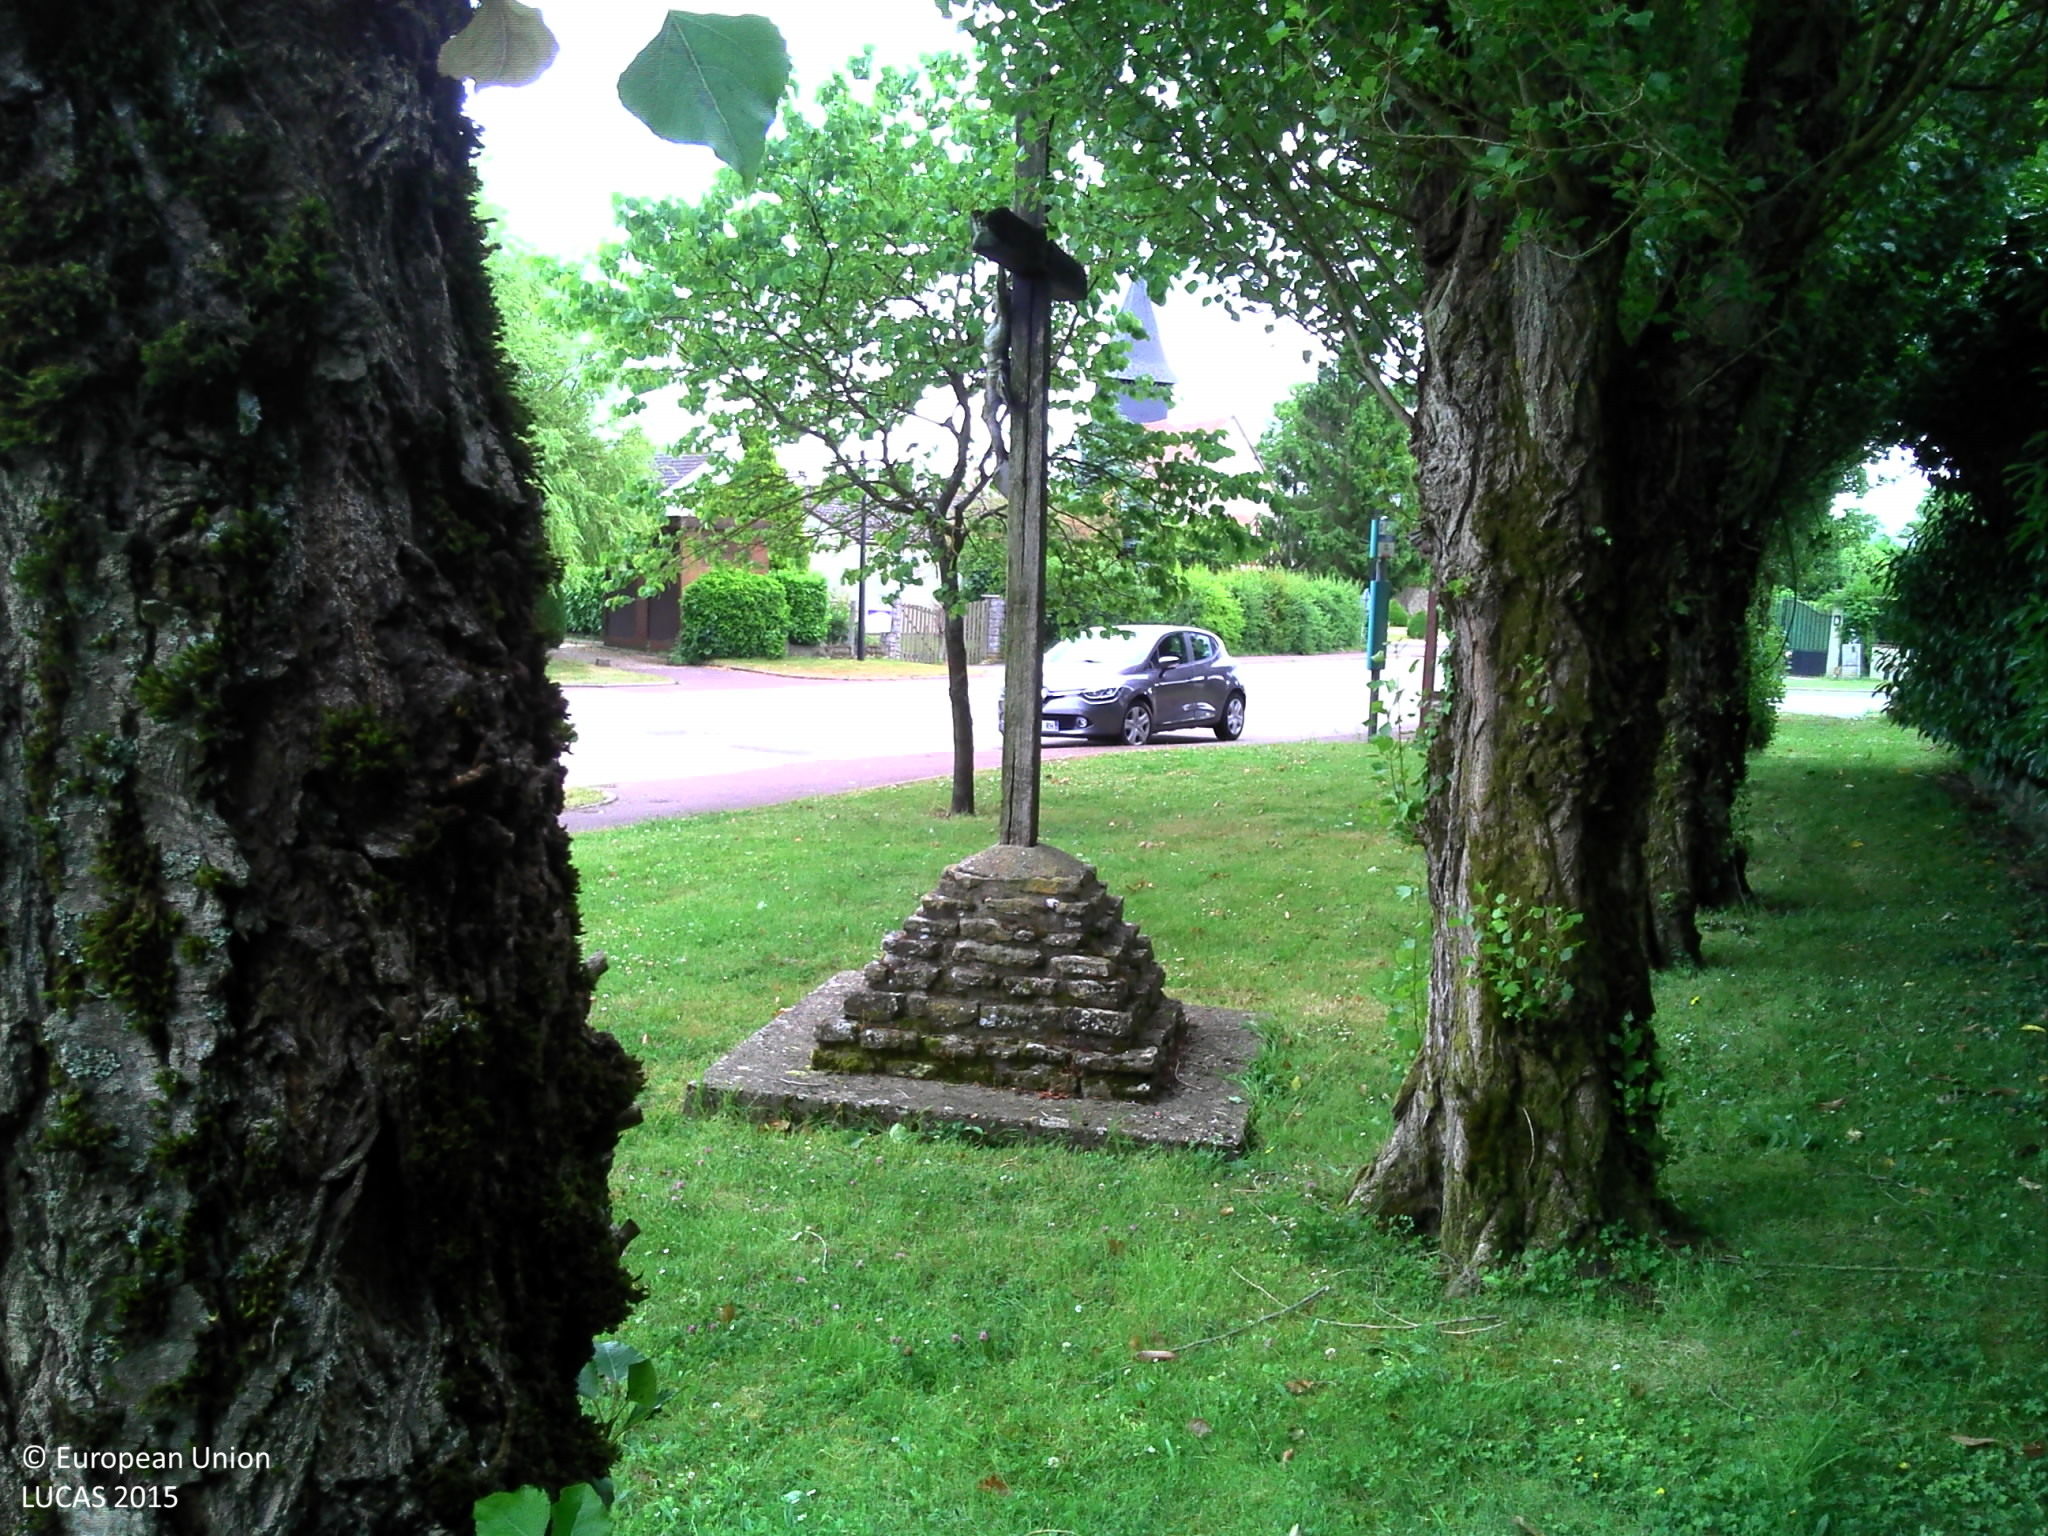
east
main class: Grassland
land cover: Grassland with sparse tree/shrub cover
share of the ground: > 75 %
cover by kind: herbaceous plants 95 %, broadleaved forest trees 5 %
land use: Residential
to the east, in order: Grassland with sparse tree/shrub cover; Artificial constructions in urban areas
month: June
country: FR
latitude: 49.0325
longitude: 1.2401
